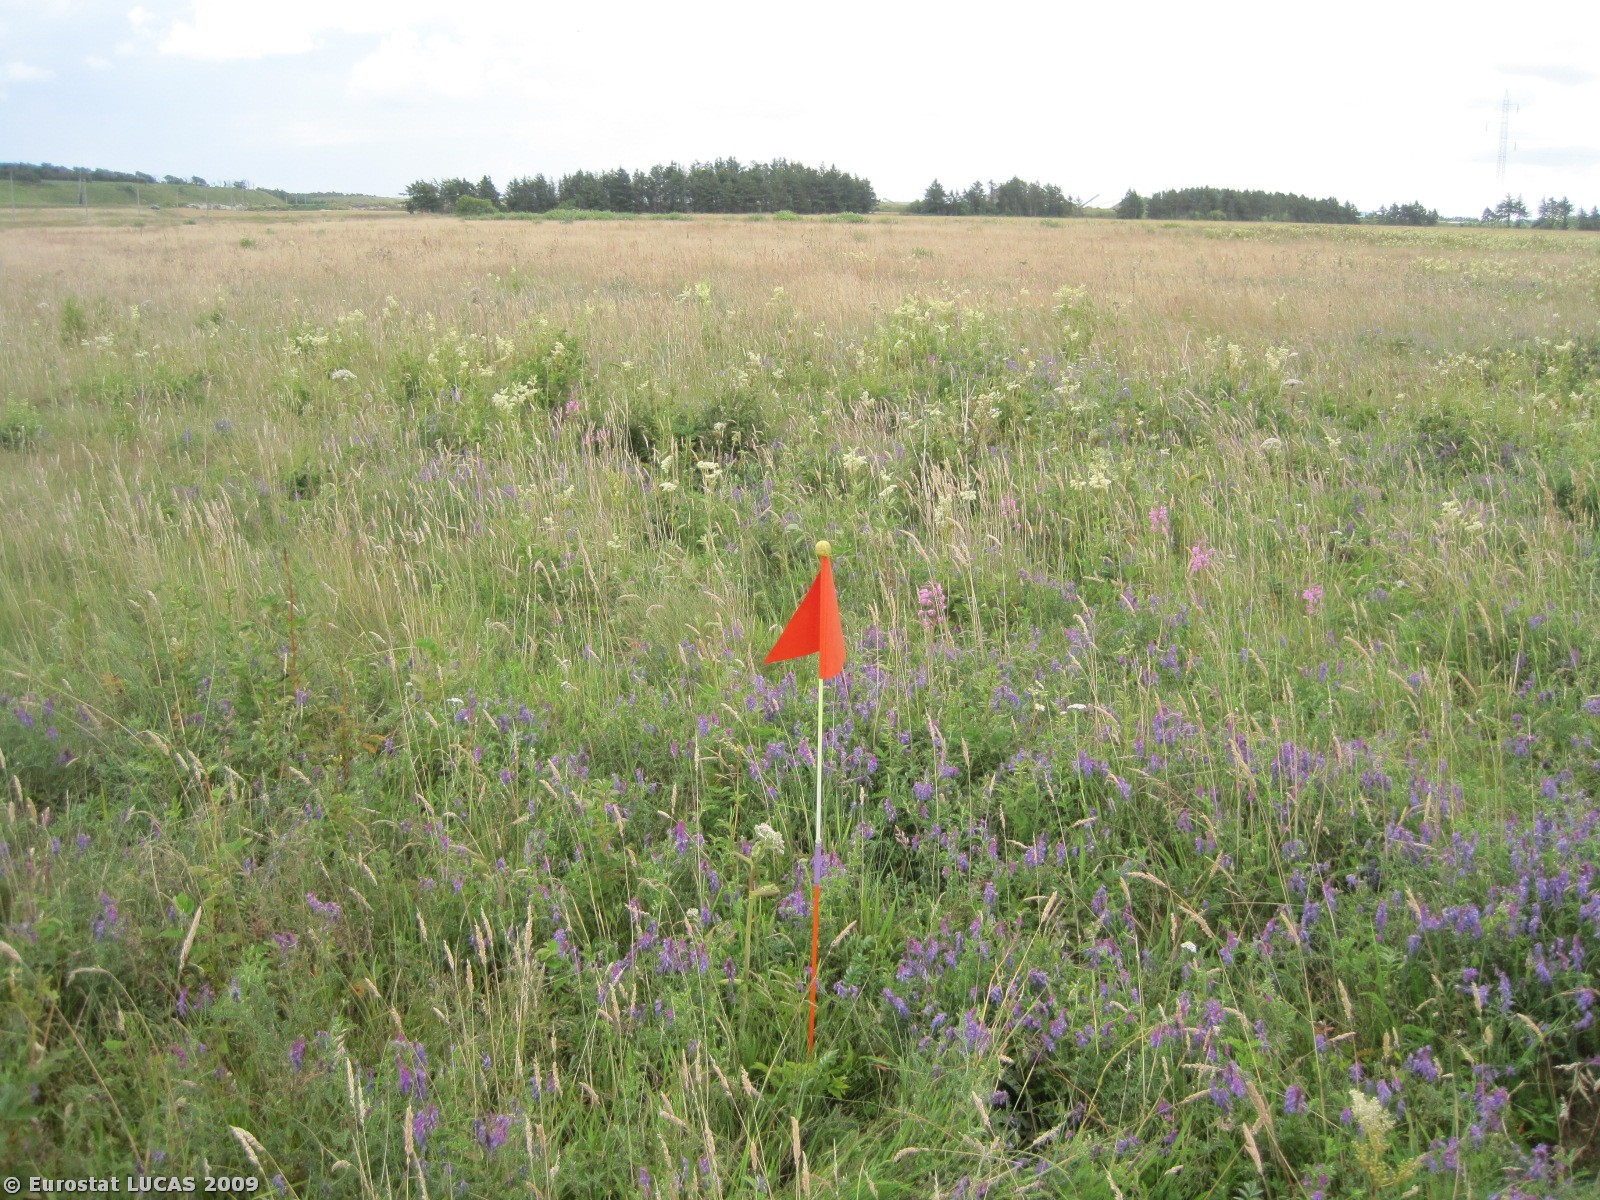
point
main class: Grassland
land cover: Grassland without tree/shrub cover
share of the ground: > 75 %
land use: Unused
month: July
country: DK
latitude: 57.0628
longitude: 8.7651
